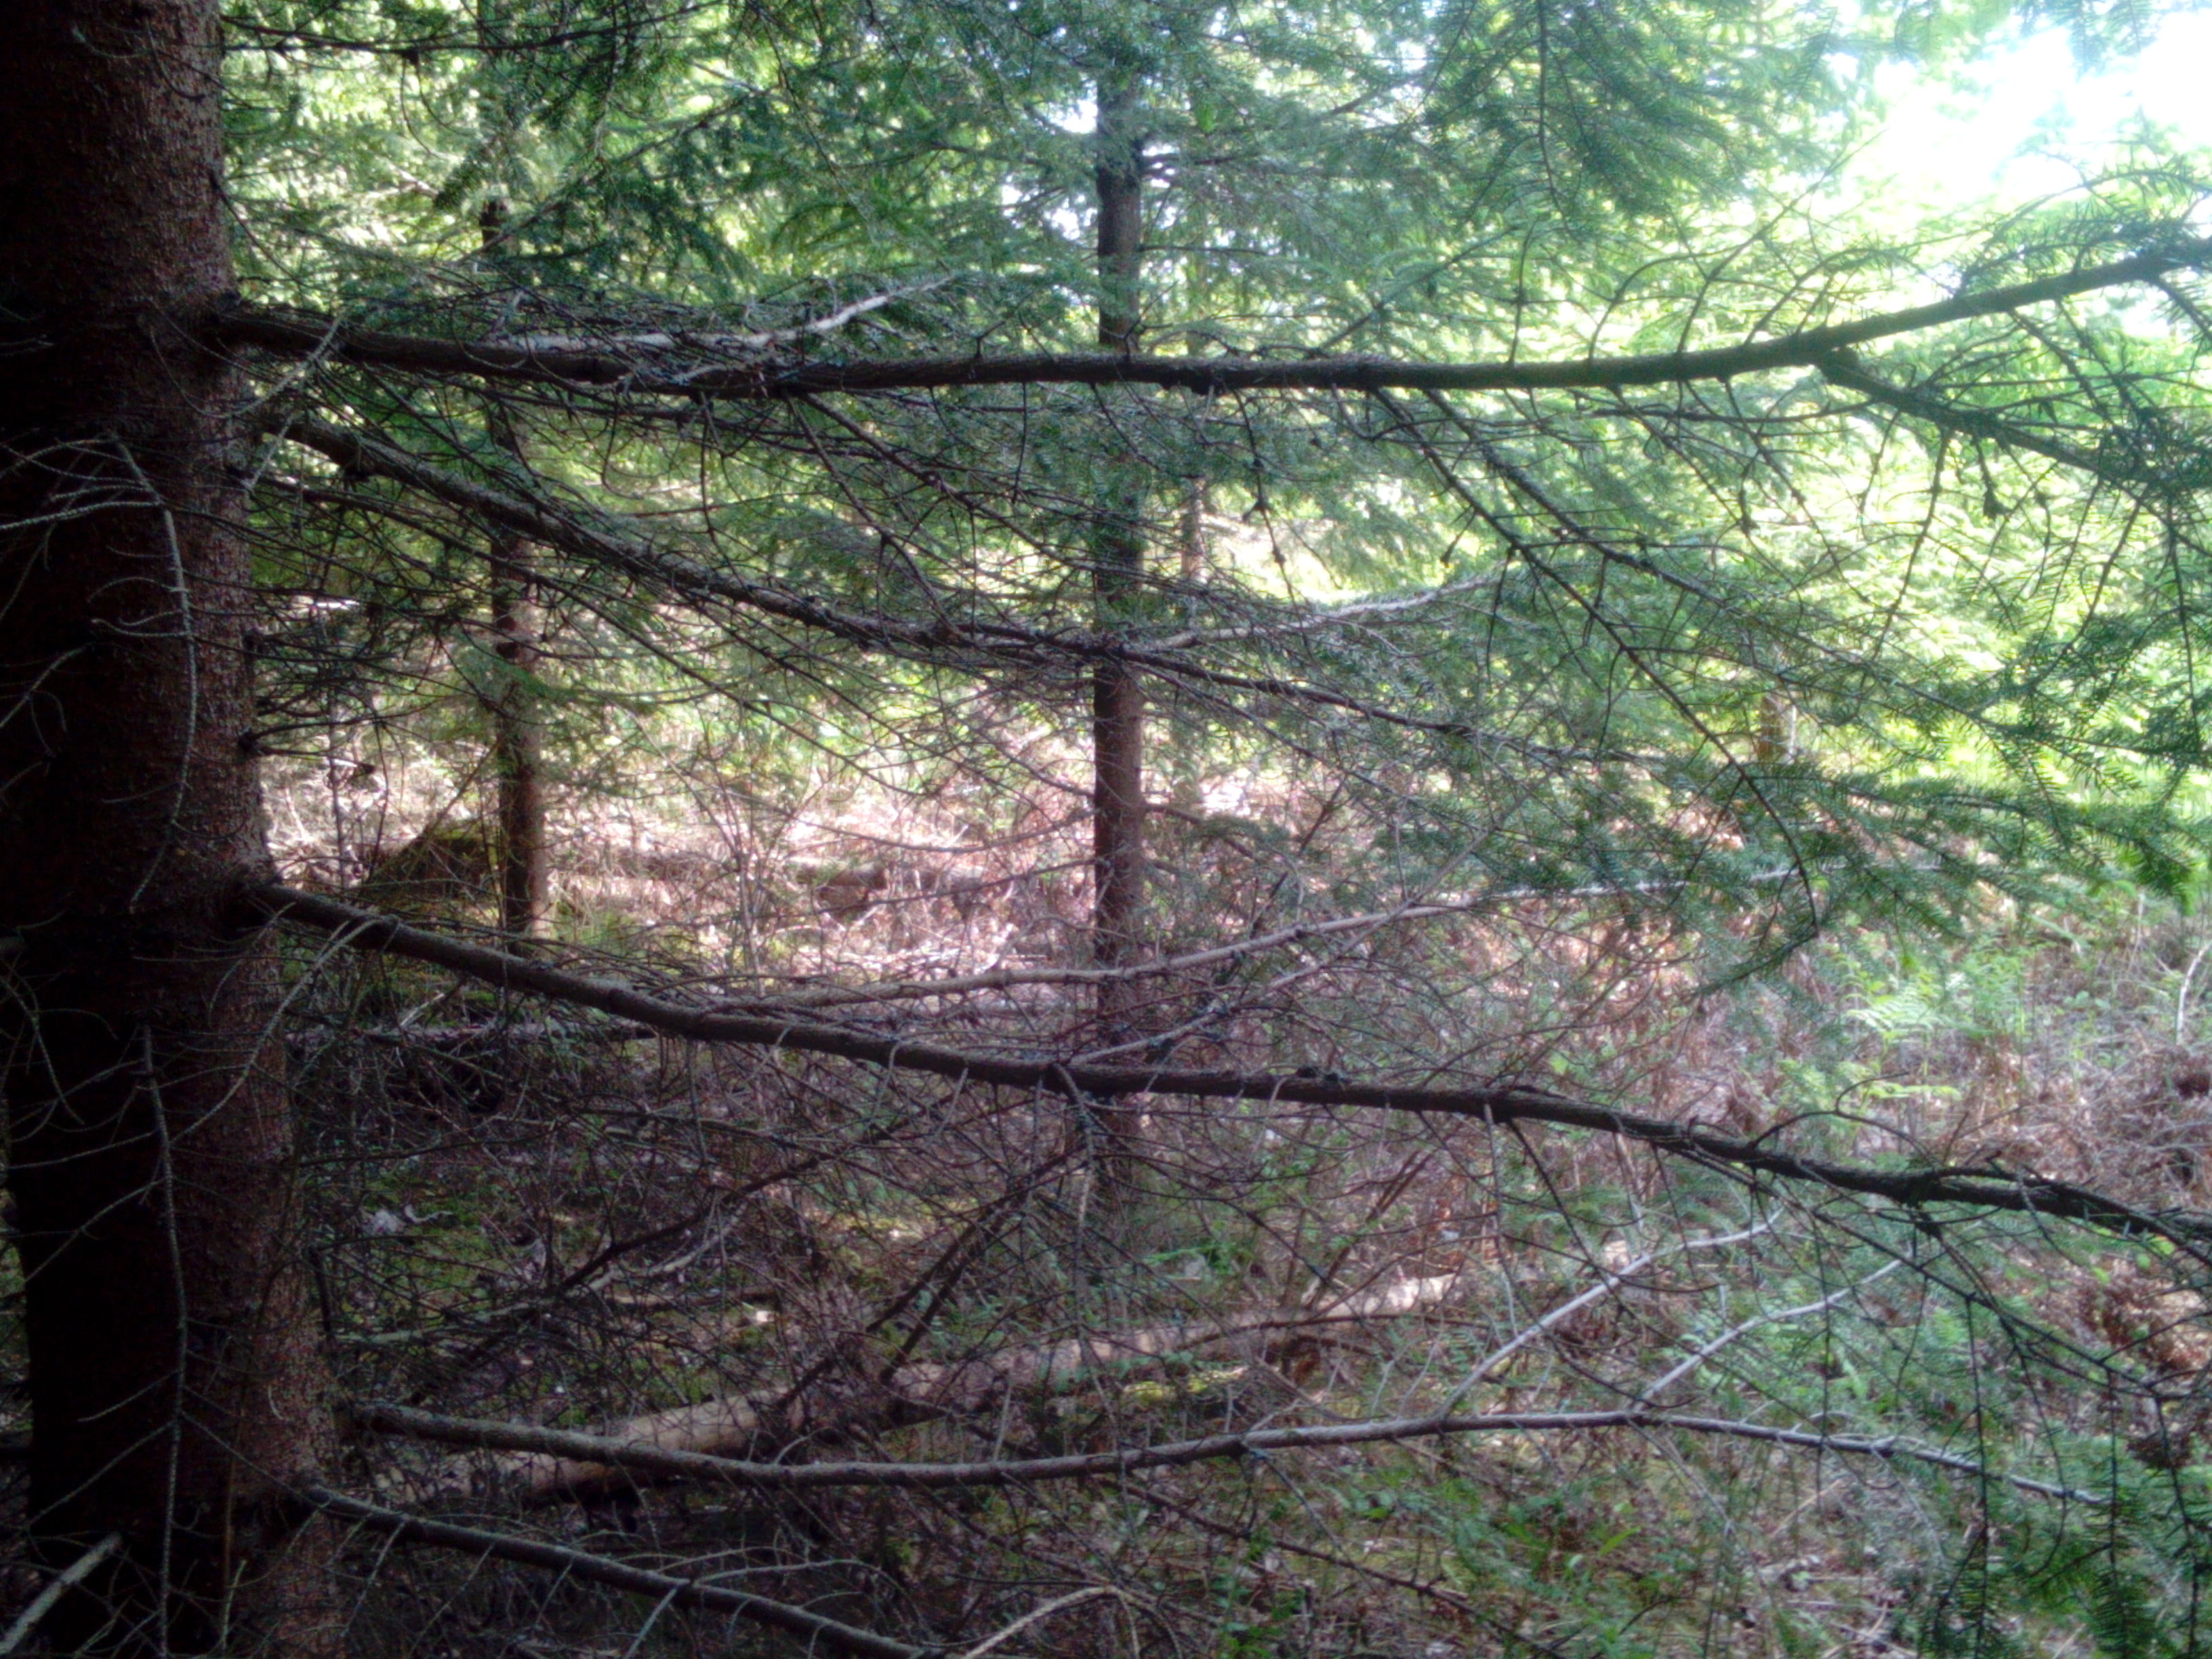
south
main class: Woodland
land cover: Spruce dominated mixed woodland
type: hemiboreal forest and nemoral coniferous forest and mixed broadleaved-coniferous forest
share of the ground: > 75 %
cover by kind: coniferous forest trees 70 %, broadleaved forest trees 30 %
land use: Forestry
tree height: > 5 m
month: June
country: LV
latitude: 56.7123
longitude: 21.8248
